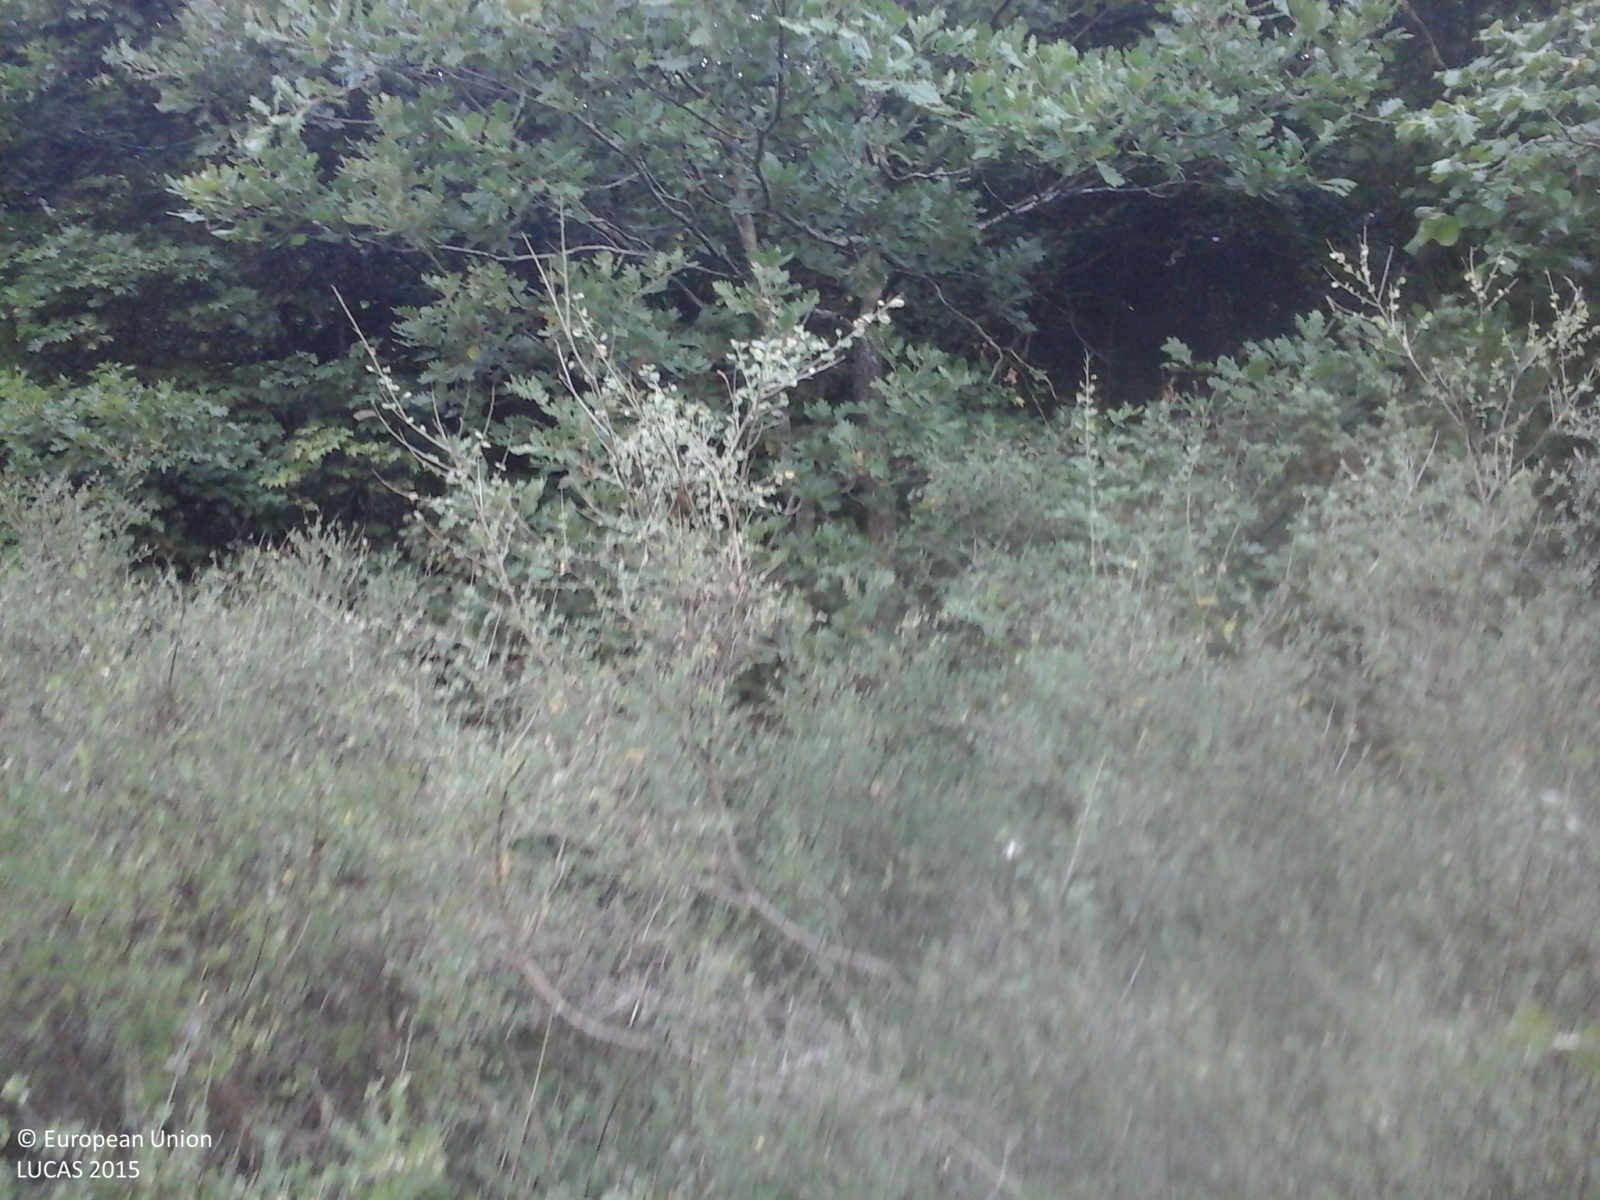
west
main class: Woodland
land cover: Broadleaved woodland
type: thermophilous deciduous forest
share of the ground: > 75 %
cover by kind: broadleaved forest trees 90 %, coniferous forest trees 5 %, shrubs 5 %
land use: Forestry
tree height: < 5 m
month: August
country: IT
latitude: 43.0079
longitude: 12.9727
